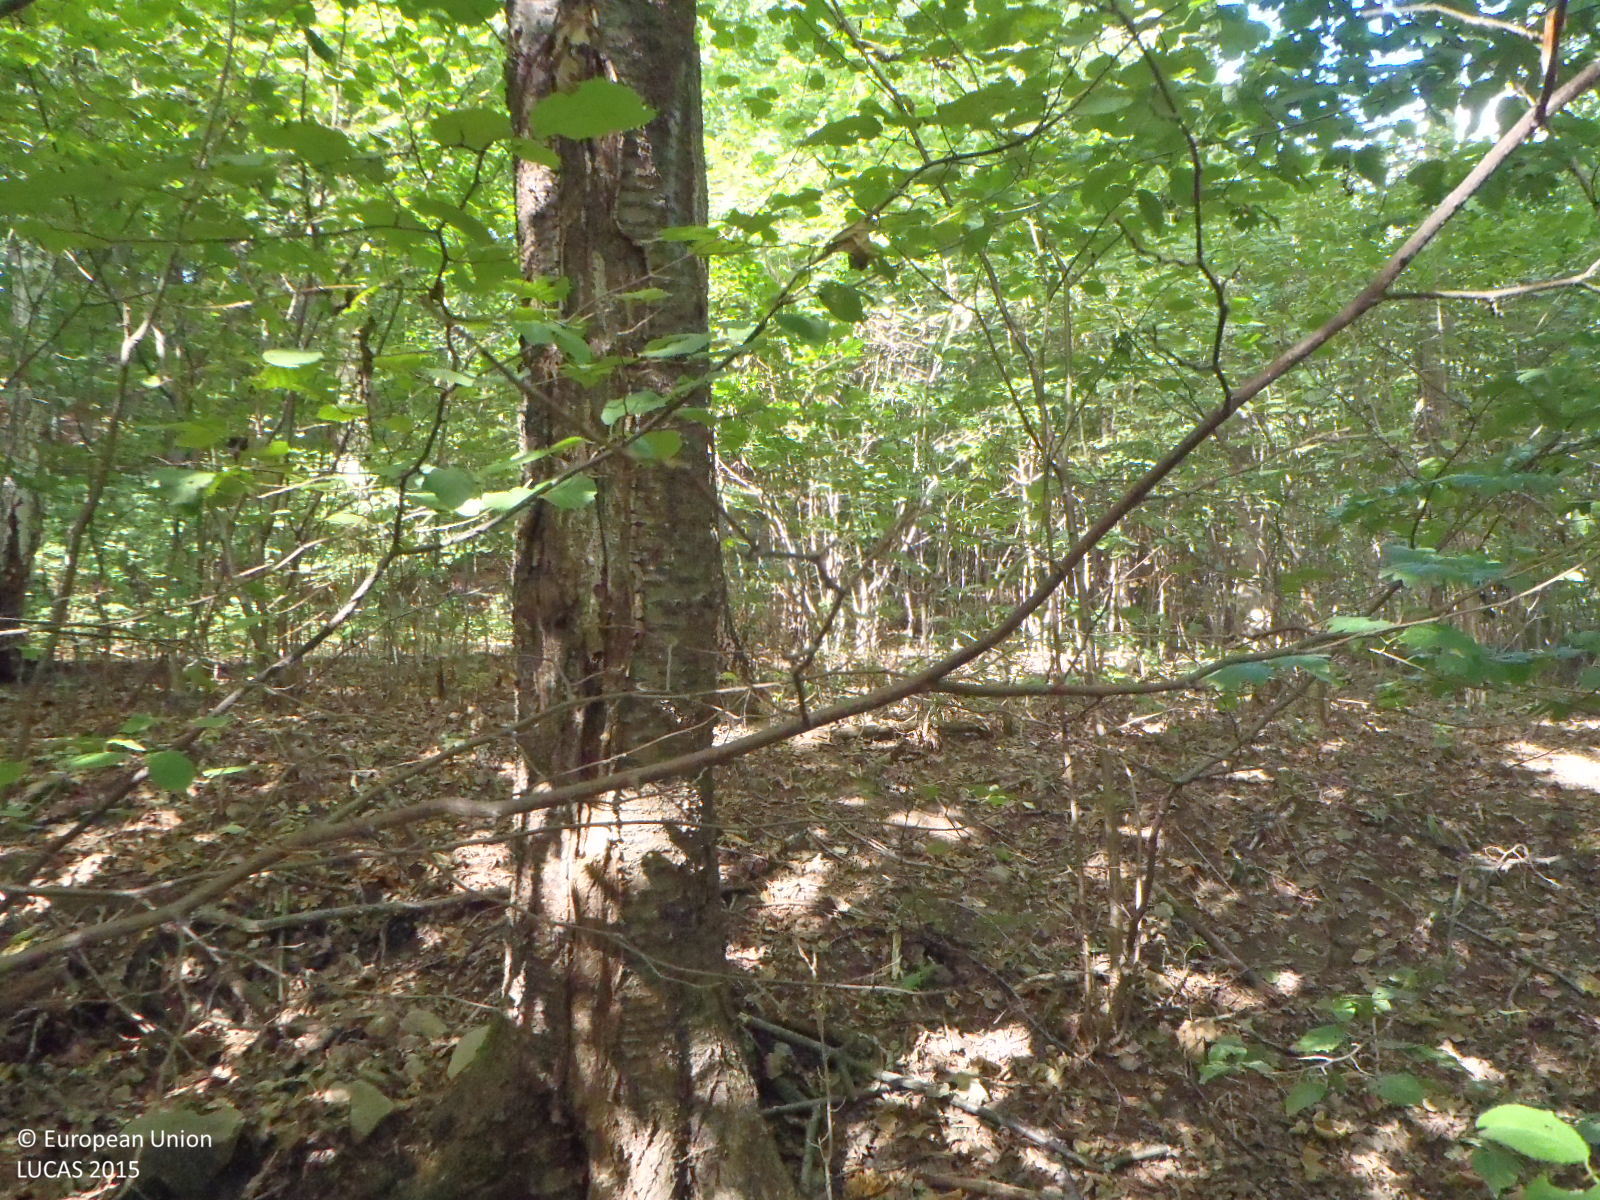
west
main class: Woodland
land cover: Broadleaved woodland
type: mesophytic deciduous forest
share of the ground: > 75 %
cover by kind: broadleaved forest trees 95 %, shrubs 5 %
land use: Forestry
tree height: > 5 m
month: September
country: CZ
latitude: 50.6850
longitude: 14.1483
